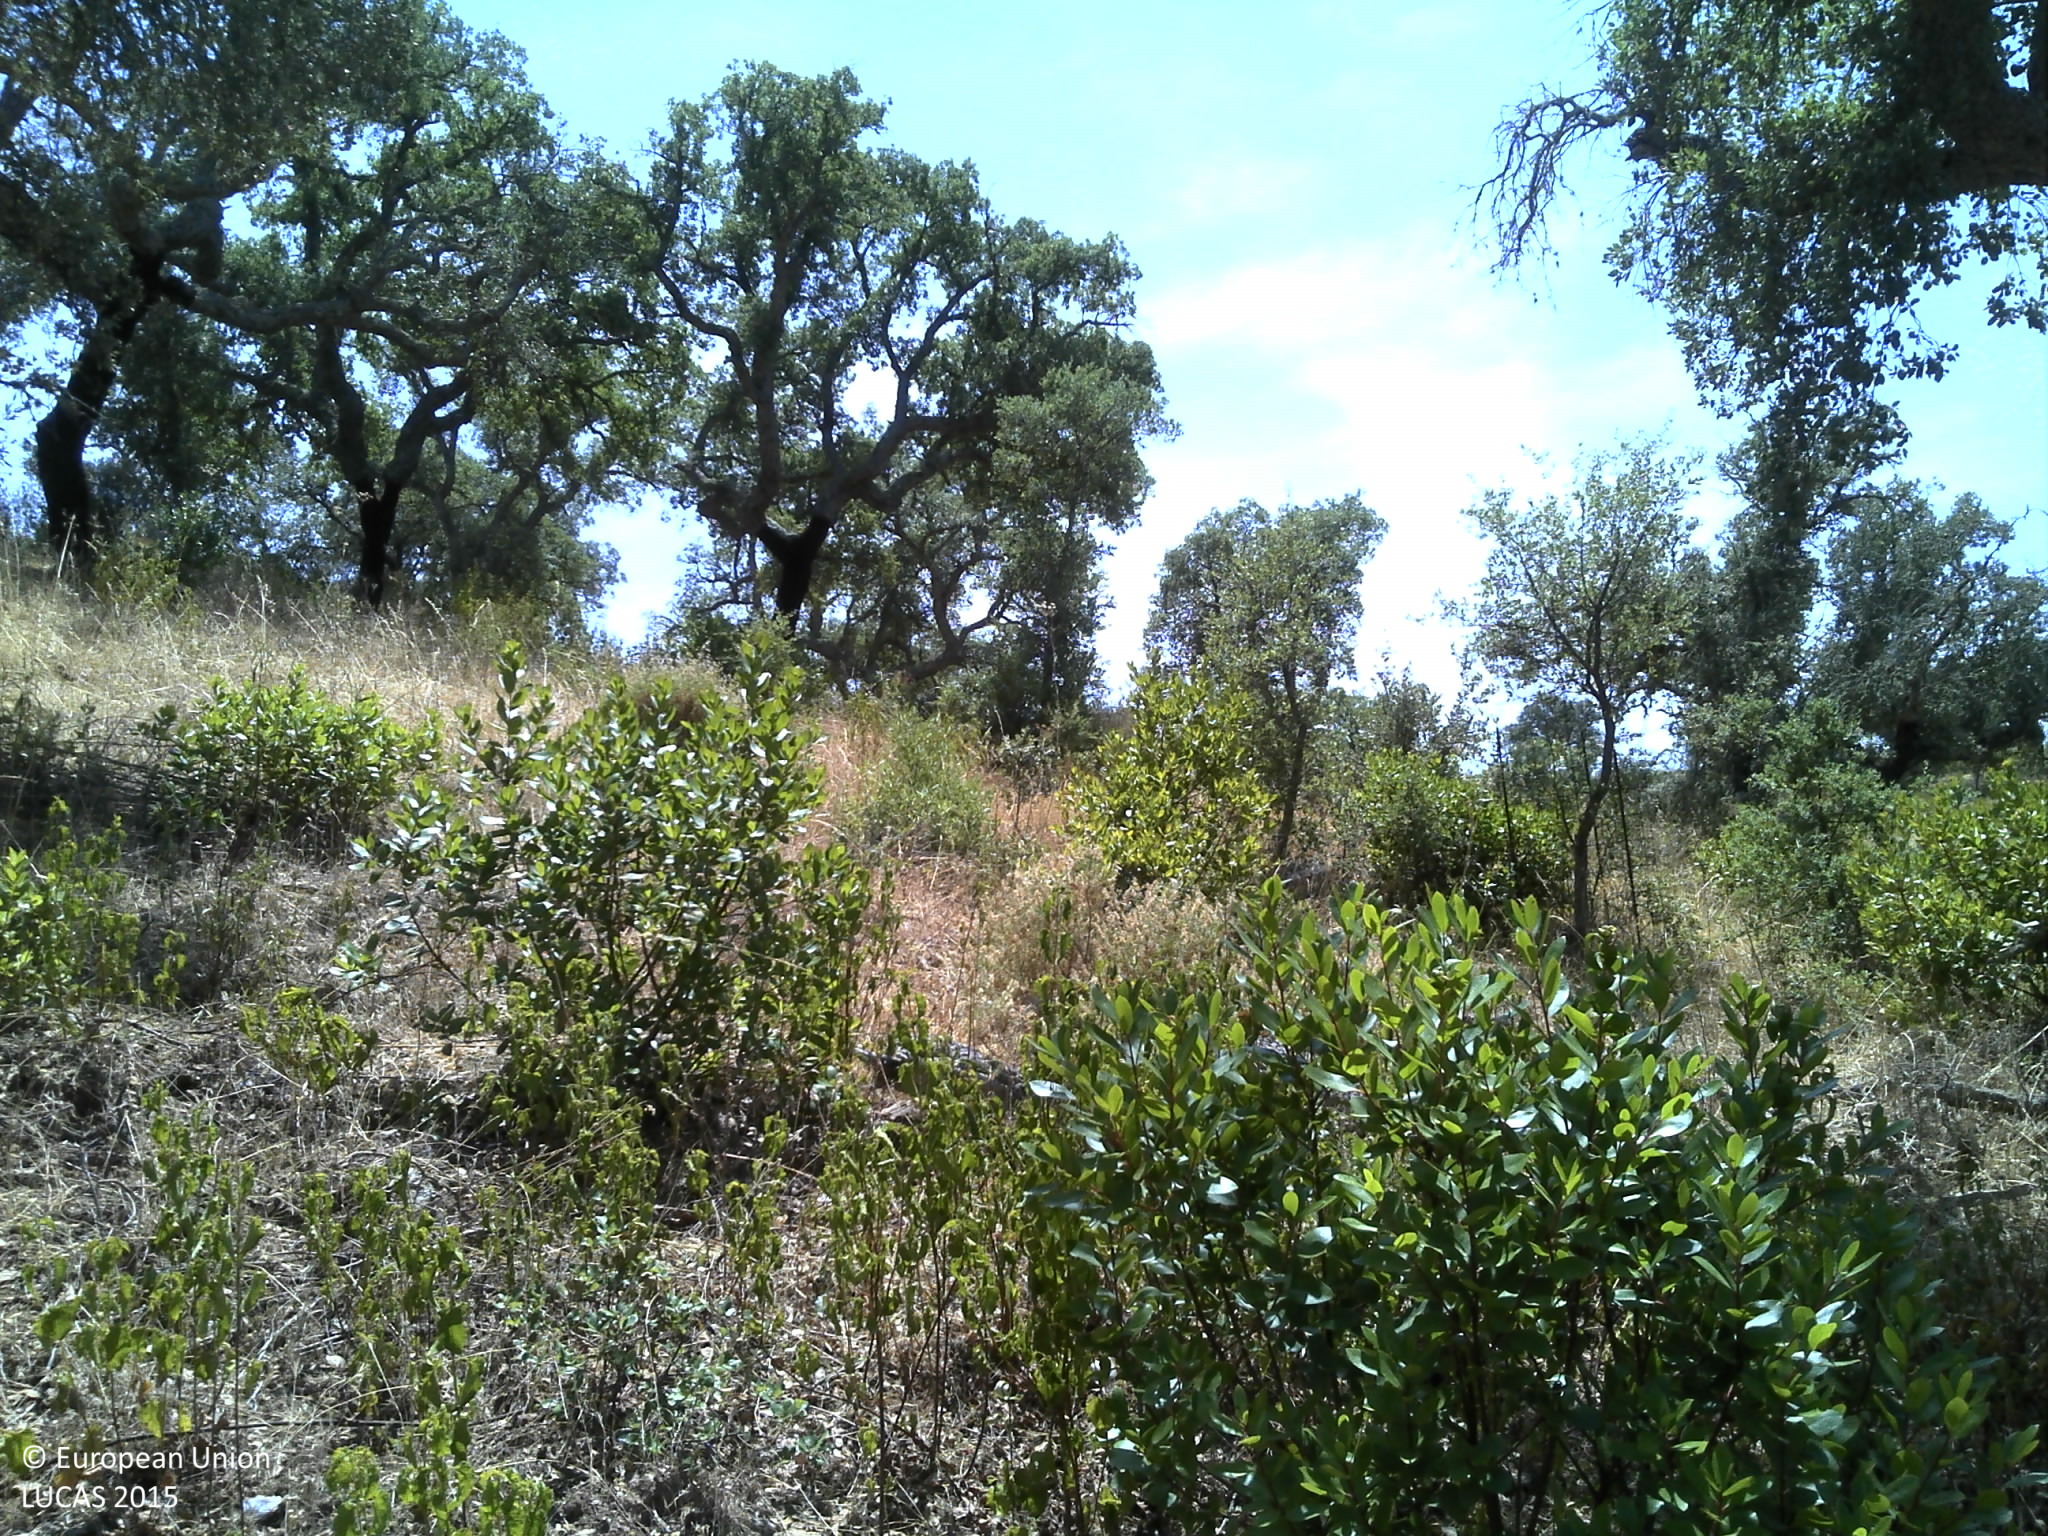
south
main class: Woodland
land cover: Broadleaved woodland
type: broadleaved evergreen forest
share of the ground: 25 - 50 %
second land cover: Shrubland without tree cover
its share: 25 - 50 %
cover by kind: unconsolidated bare surface 40 %, broadleaved forest trees 25 %, shrubs 25 %, herbaceous plants 10 %
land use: Forestry
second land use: Agriculture (excluding fallow land and kitchen gardens)
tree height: > 5 m
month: July
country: PT
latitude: 38.2573
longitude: -7.5910
